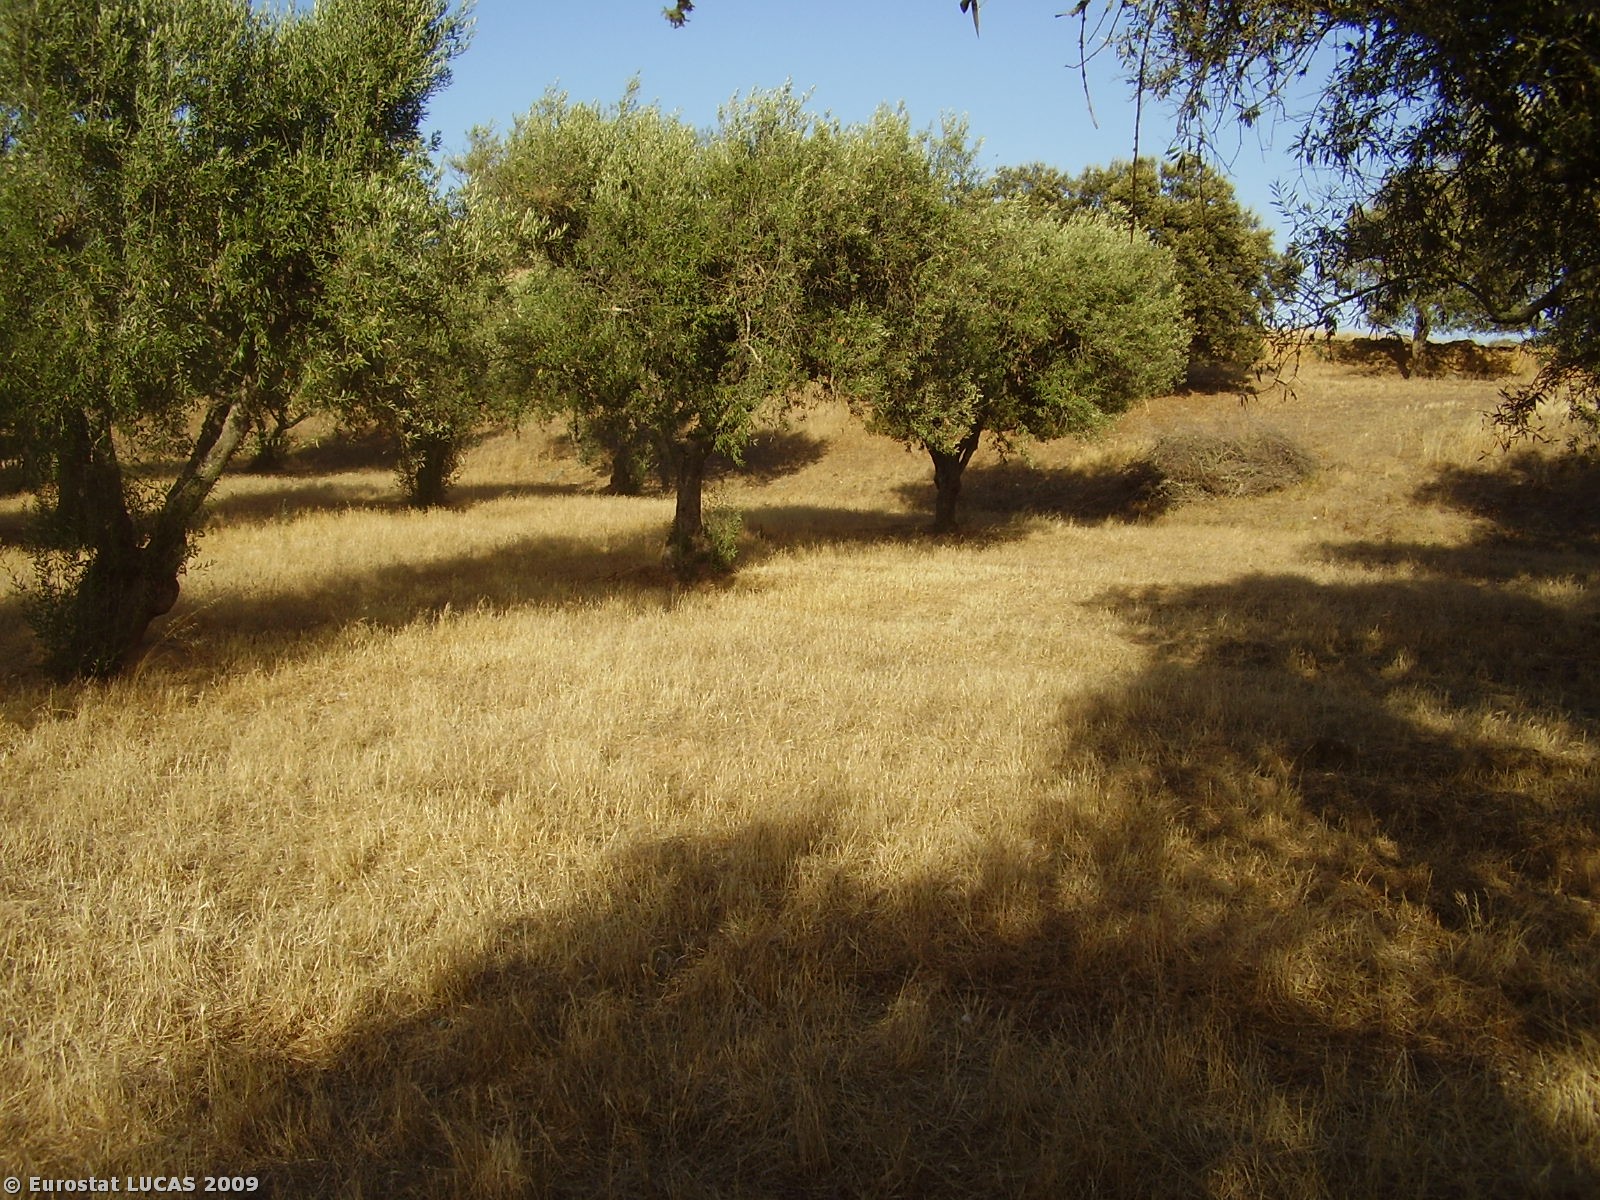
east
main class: Cropland
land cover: Olive groves
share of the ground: 25 - 50 %
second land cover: Spontaneously vegetated surfaces
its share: 50 - 75 %
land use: Agriculture (excluding fallow land and kitchen gardens)
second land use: Fallow land
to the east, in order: Olive groves; Spontaneously vegetated surfaces; Olive groves; Dry stone walls; Spontaneously vegetated surfaces; Fences; Oats; Tracks; Spontaneously vegetated surfaces; Fences; Broadleaved woodland; Rivers and streams; Broadleaved woodland
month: July
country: PT
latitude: 37.7454
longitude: -7.7580
